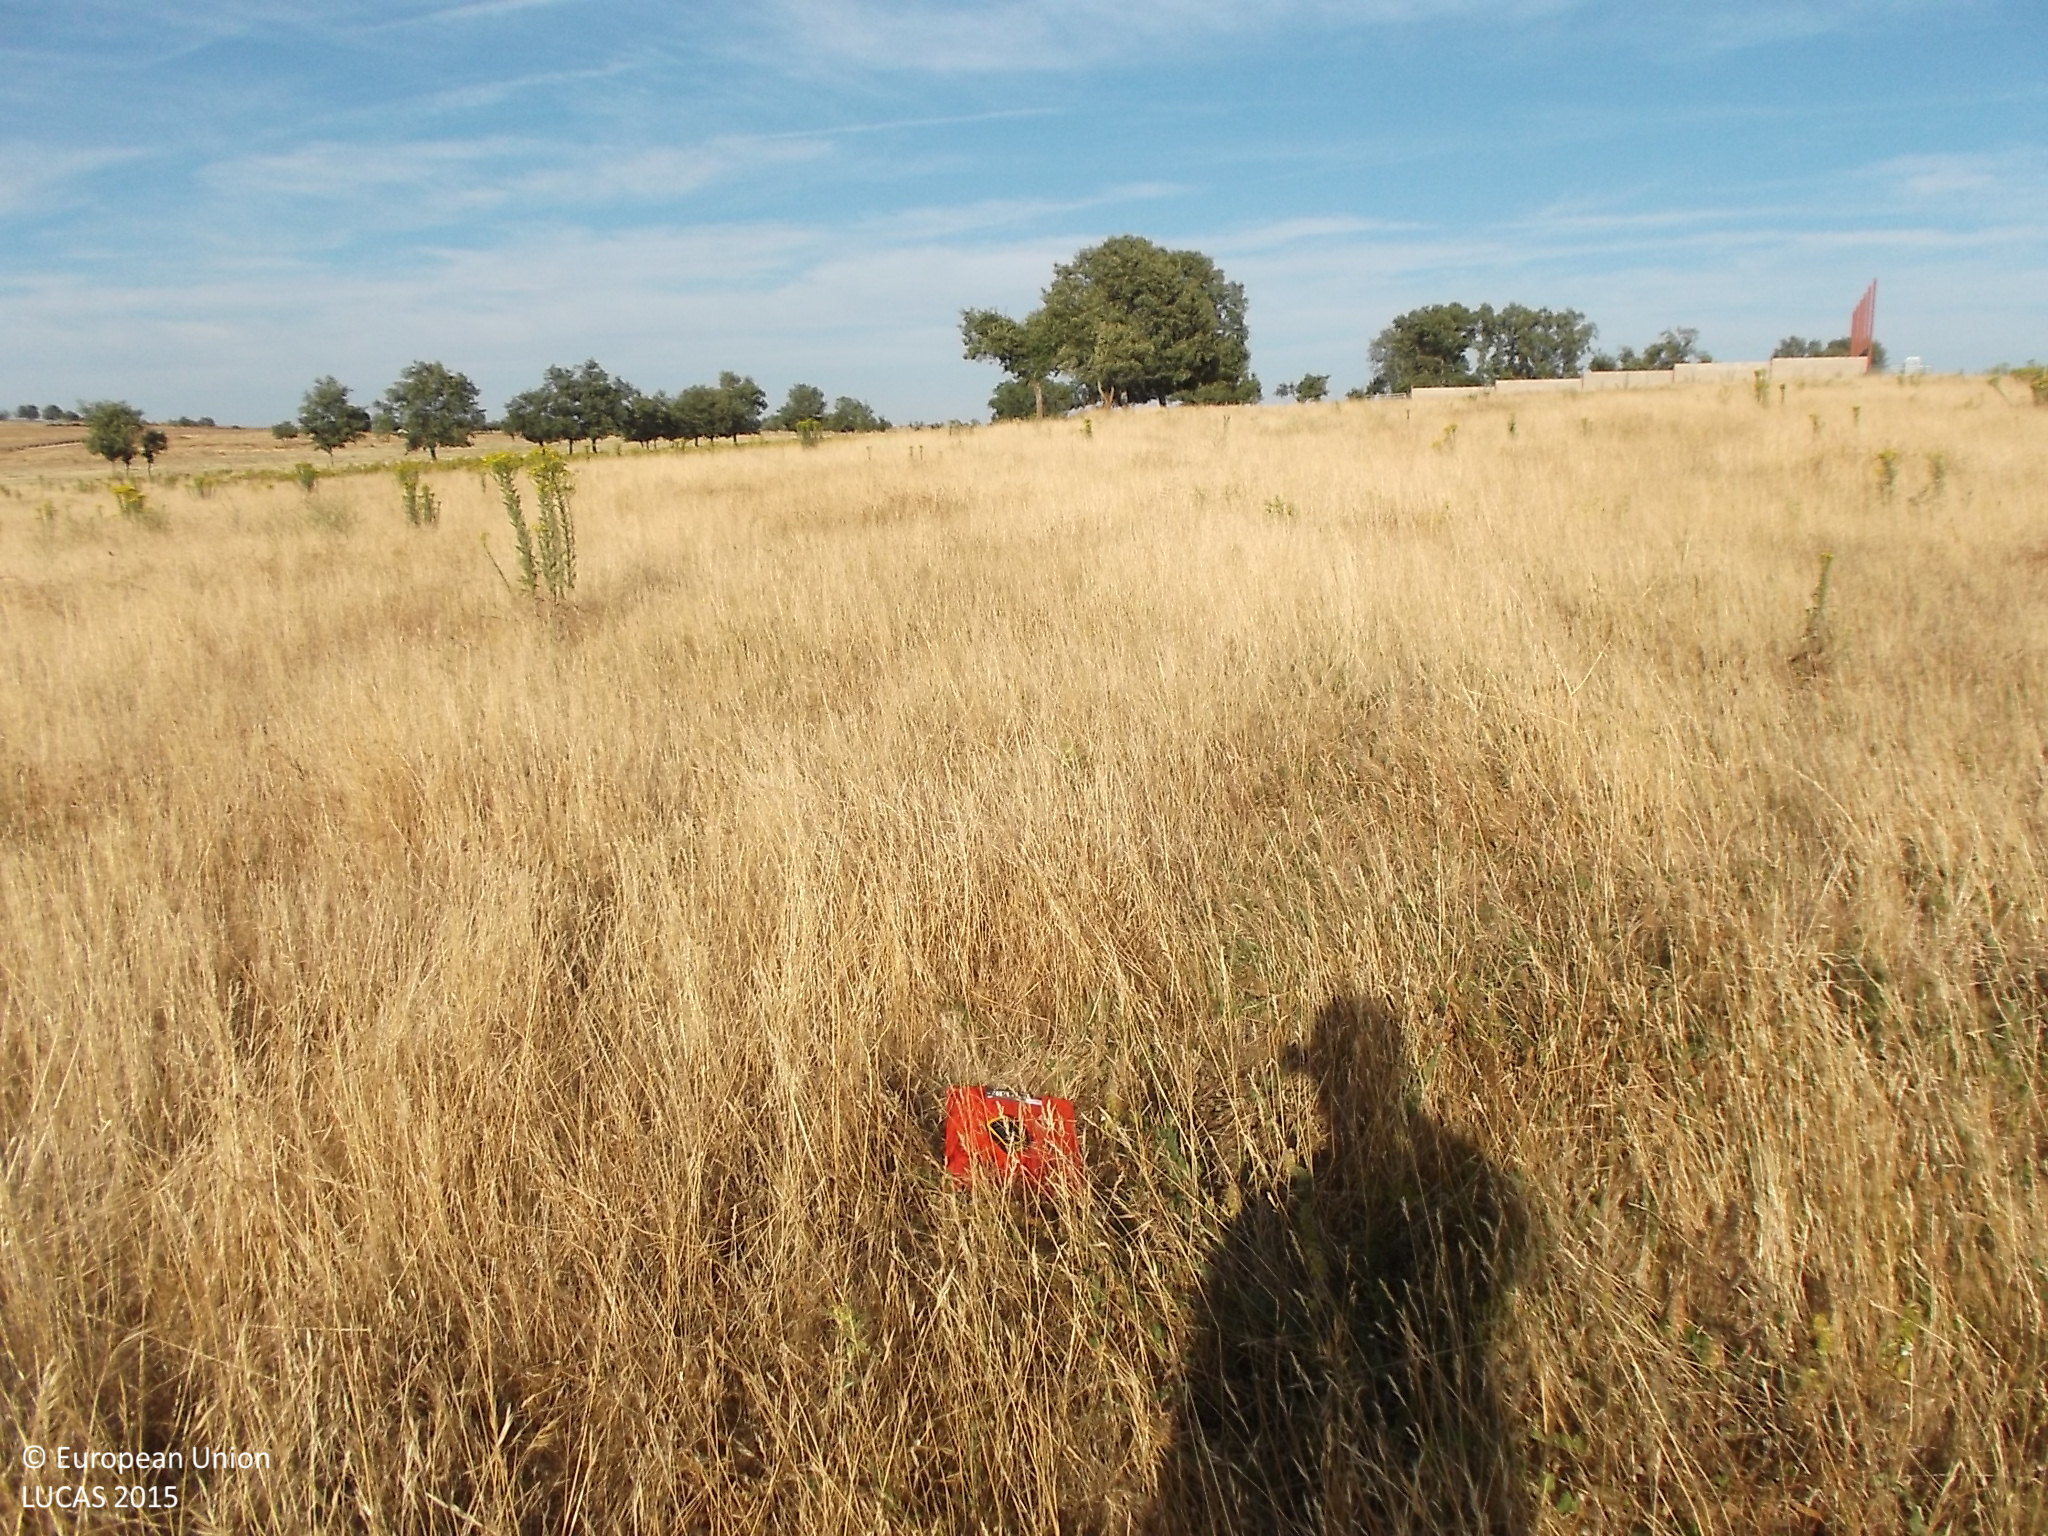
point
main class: Grassland
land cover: Grassland without tree/shrub cover
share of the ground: > 75 %
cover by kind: herbaceous plants 100 %
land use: Agriculture (excluding fallow land and kitchen gardens)
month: July
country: ES
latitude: 41.0189
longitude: -6.4700
